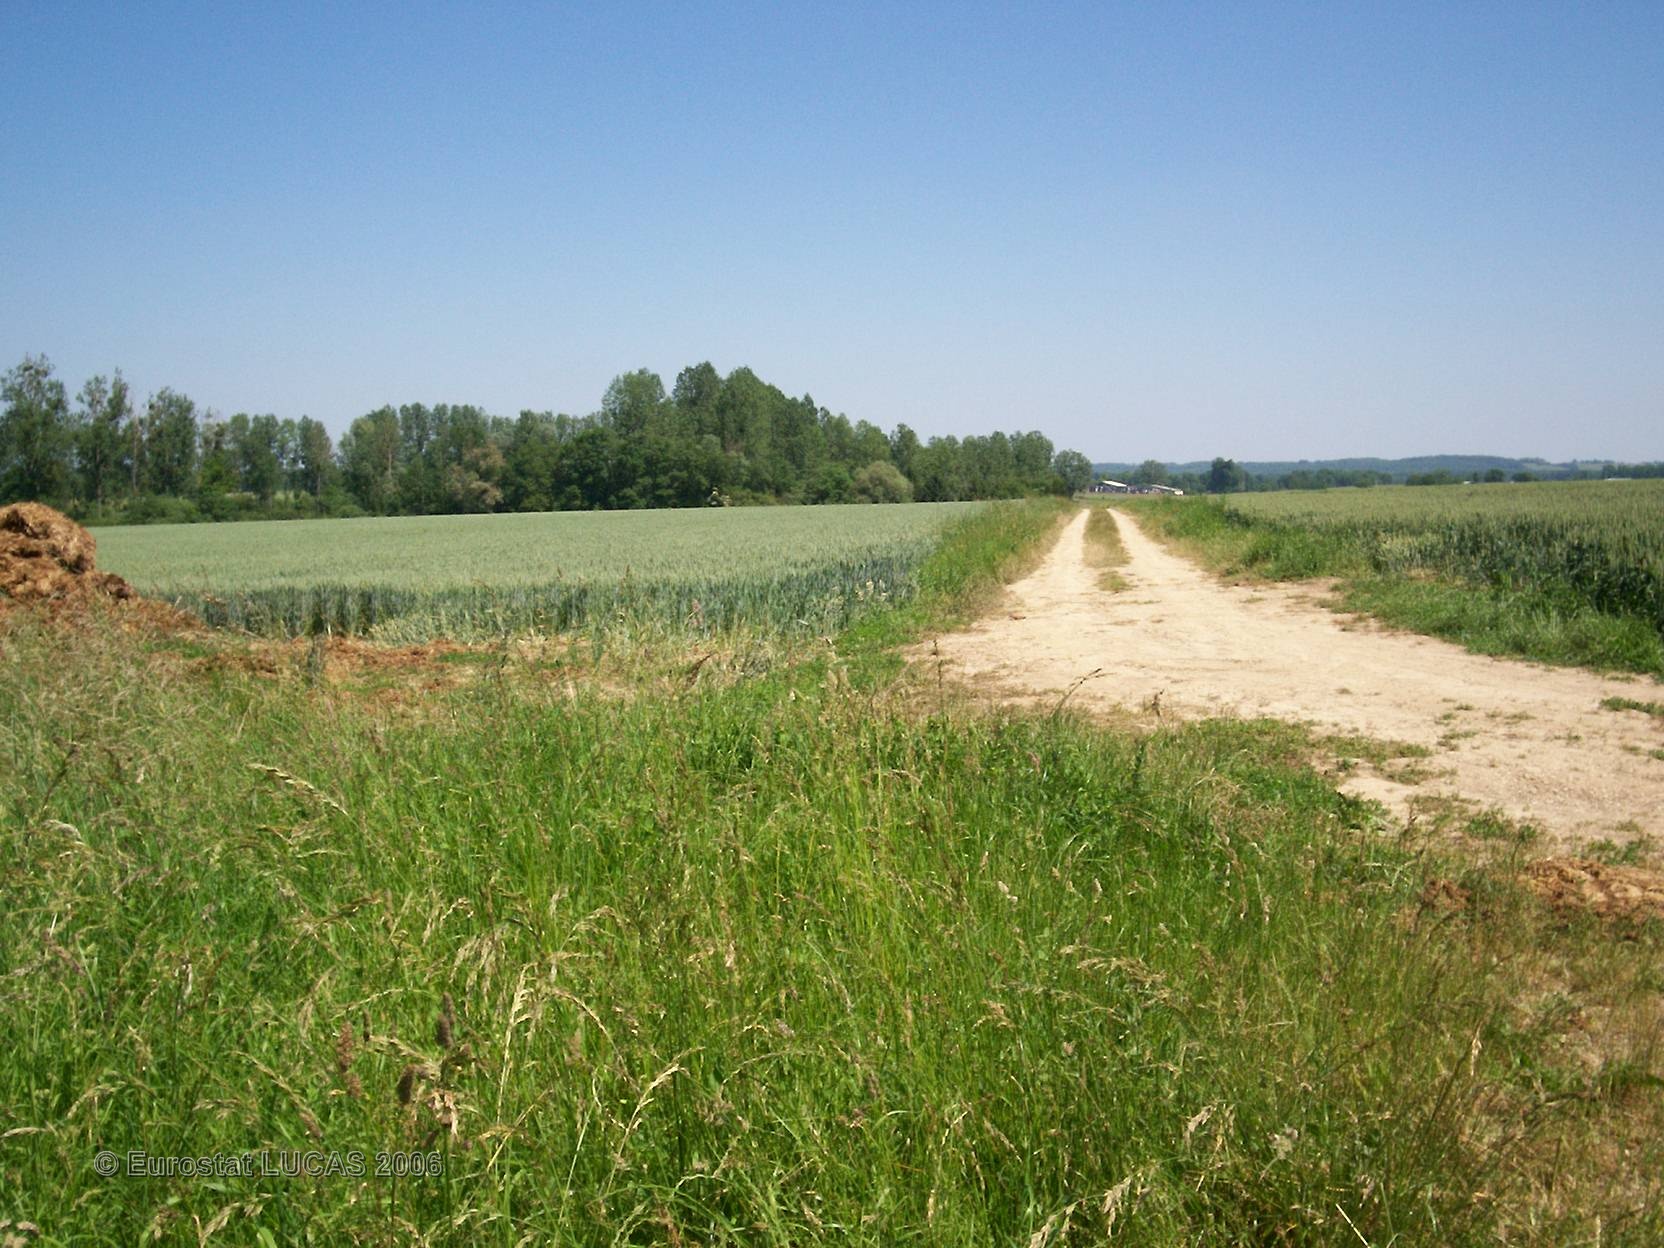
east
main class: Grassland
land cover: Grassland without tree/shrub cover
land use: Agriculture (excluding fallow land and kitchen gardens)
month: June
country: FR
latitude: 48.8583
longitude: 4.8045
